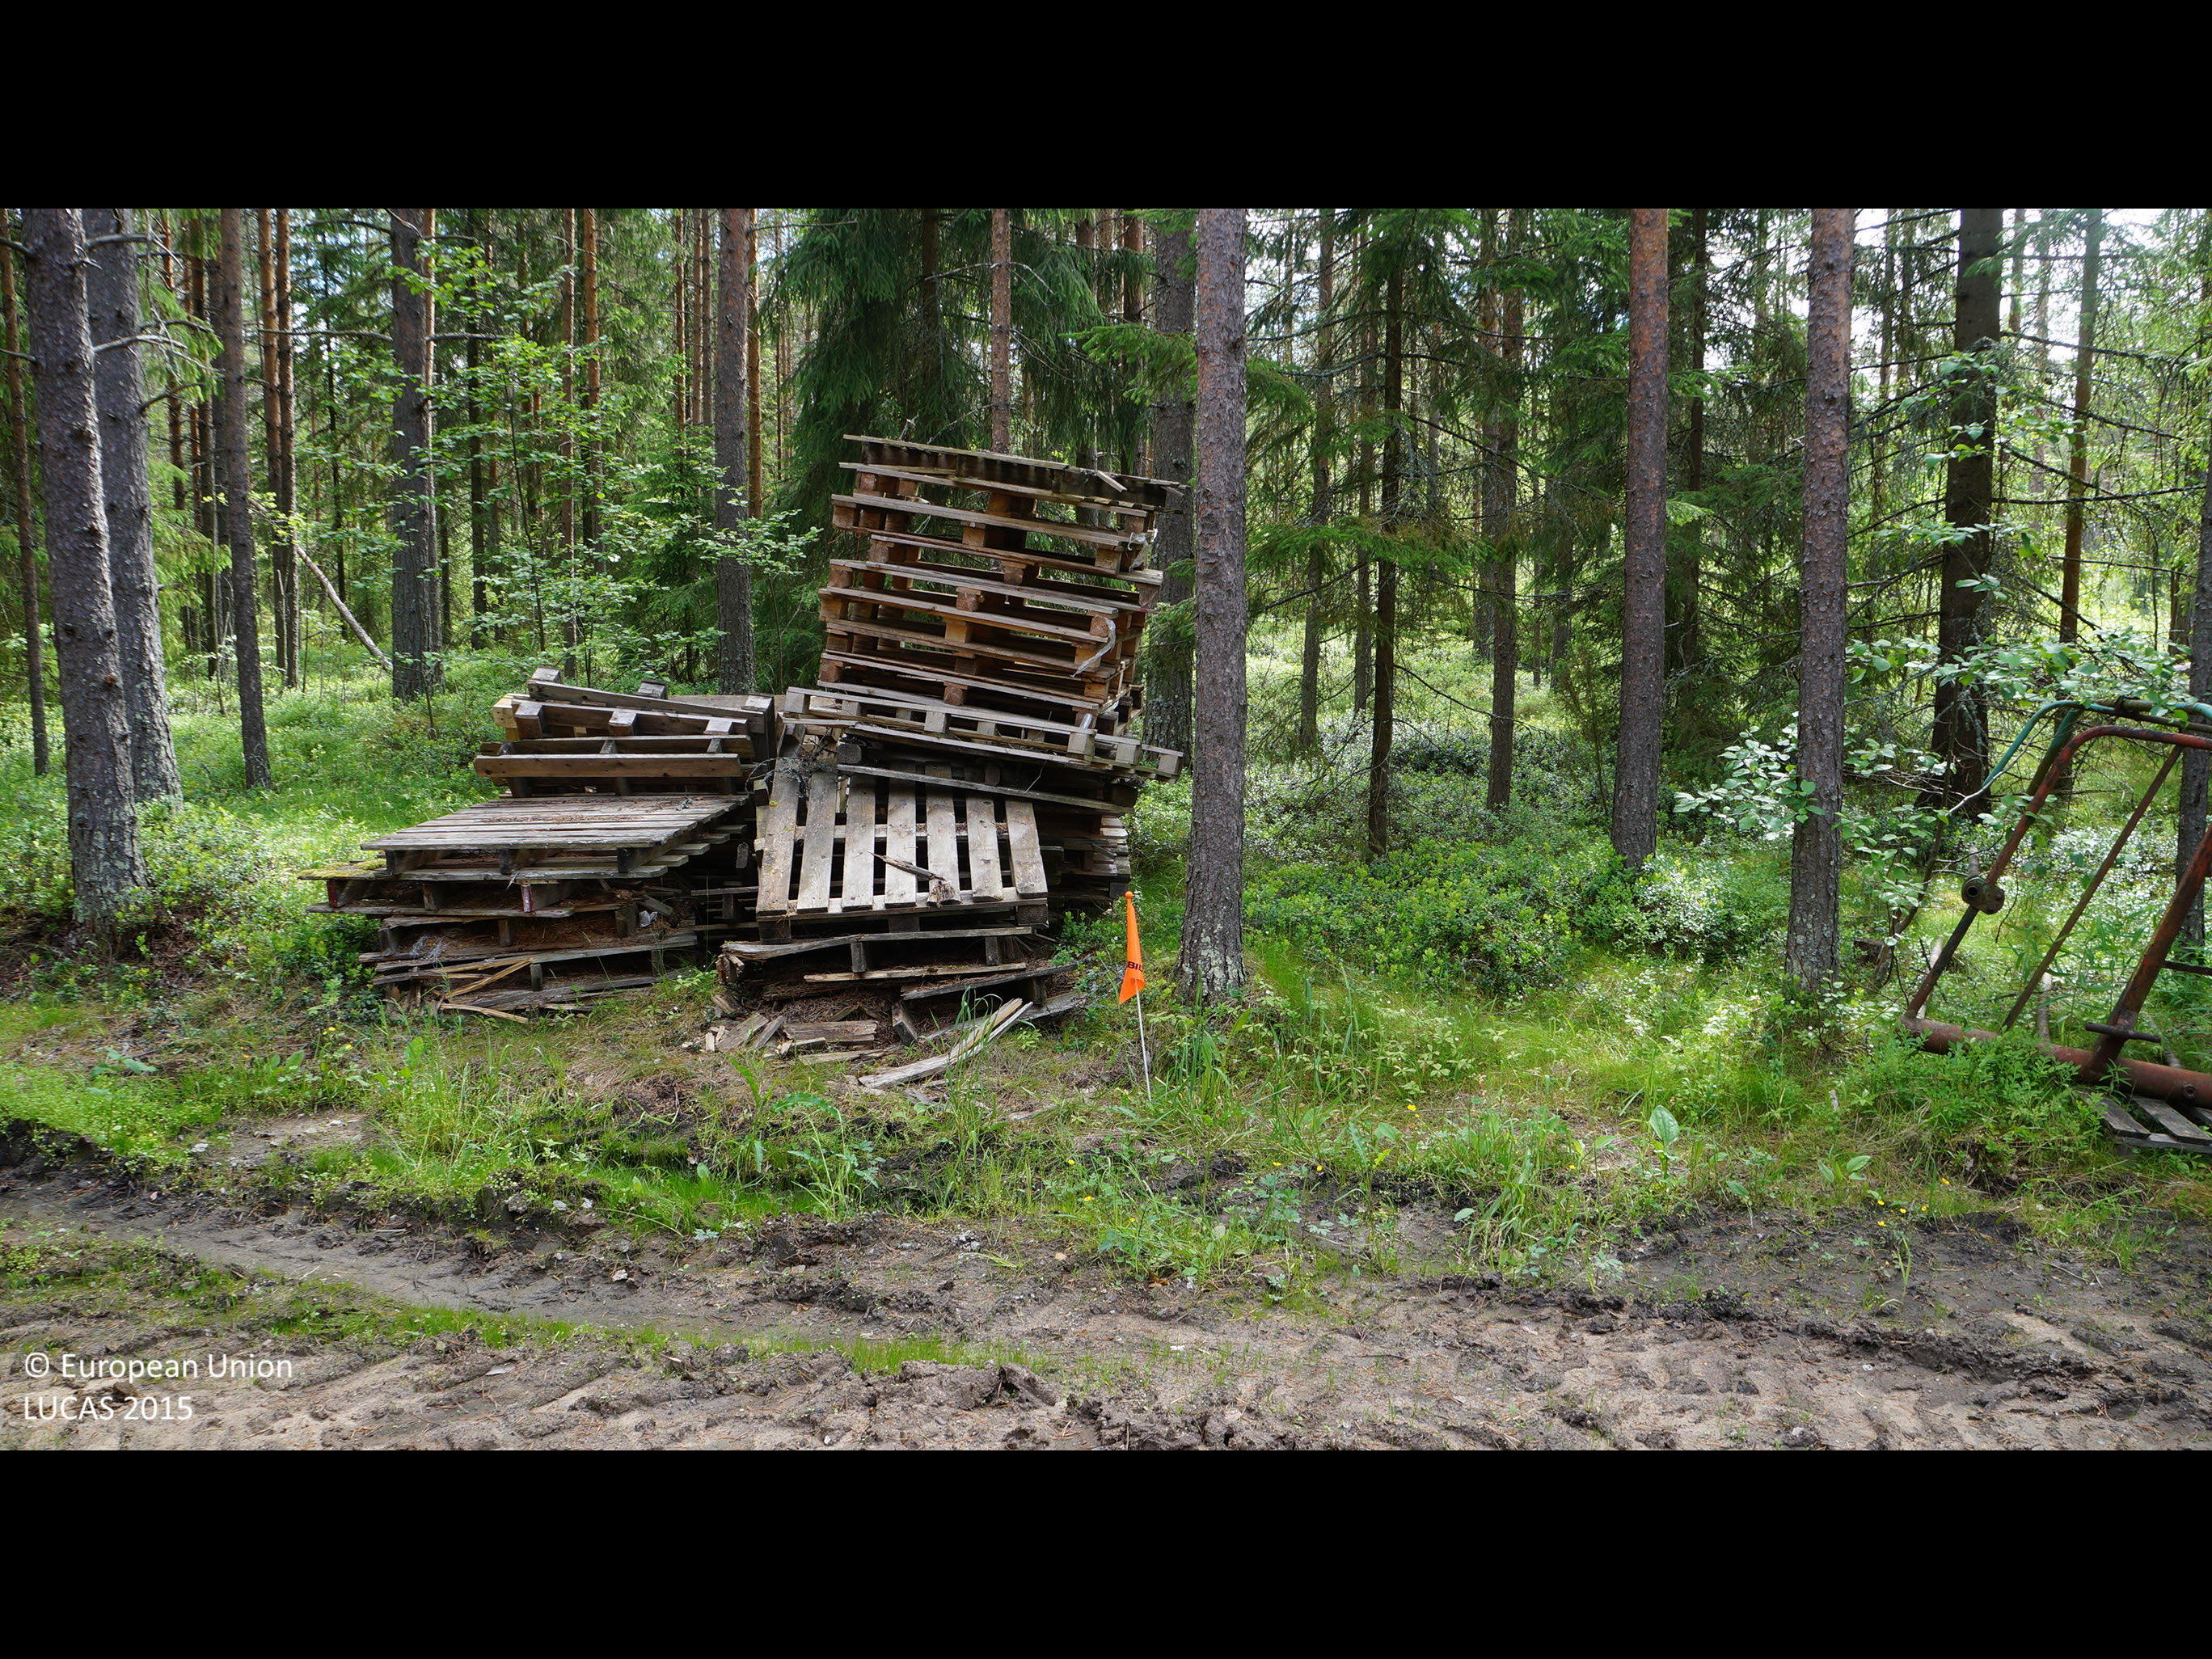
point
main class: Woodland
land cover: Pine dominated coniferous woodland
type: boreal forest
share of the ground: 50 - 75 %
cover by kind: coniferous forest trees 60 %, shrubs 30 %, herbaceous plants 5 %, lichens and mosses 5 %
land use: Forestry
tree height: > 5 m
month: July
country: FI
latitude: 64.3435
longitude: 24.4145
